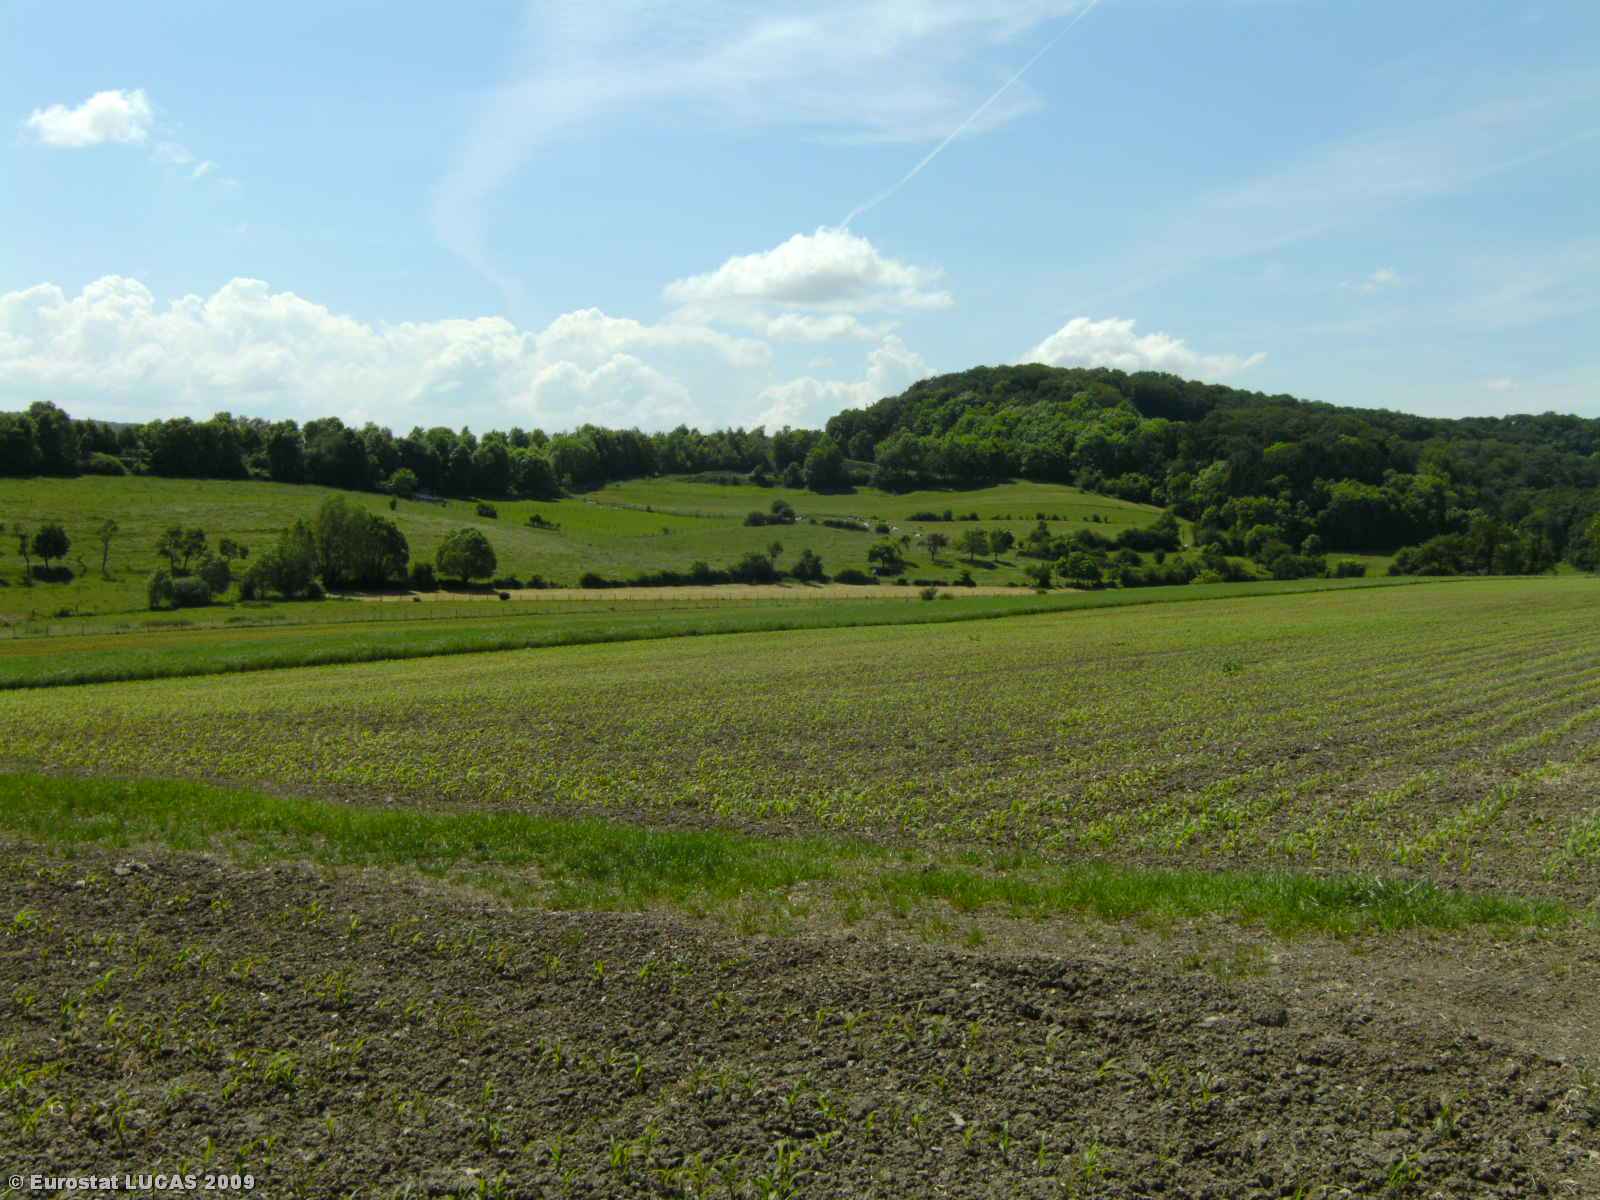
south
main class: Cropland
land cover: Apple fruit
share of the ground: 10 - 25 %
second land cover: Grassland with sparse tree/shrub cover
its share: > 75 %
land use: Agriculture (excluding fallow land and kitchen gardens)
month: June
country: LU
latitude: 49.5485
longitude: 6.3093
